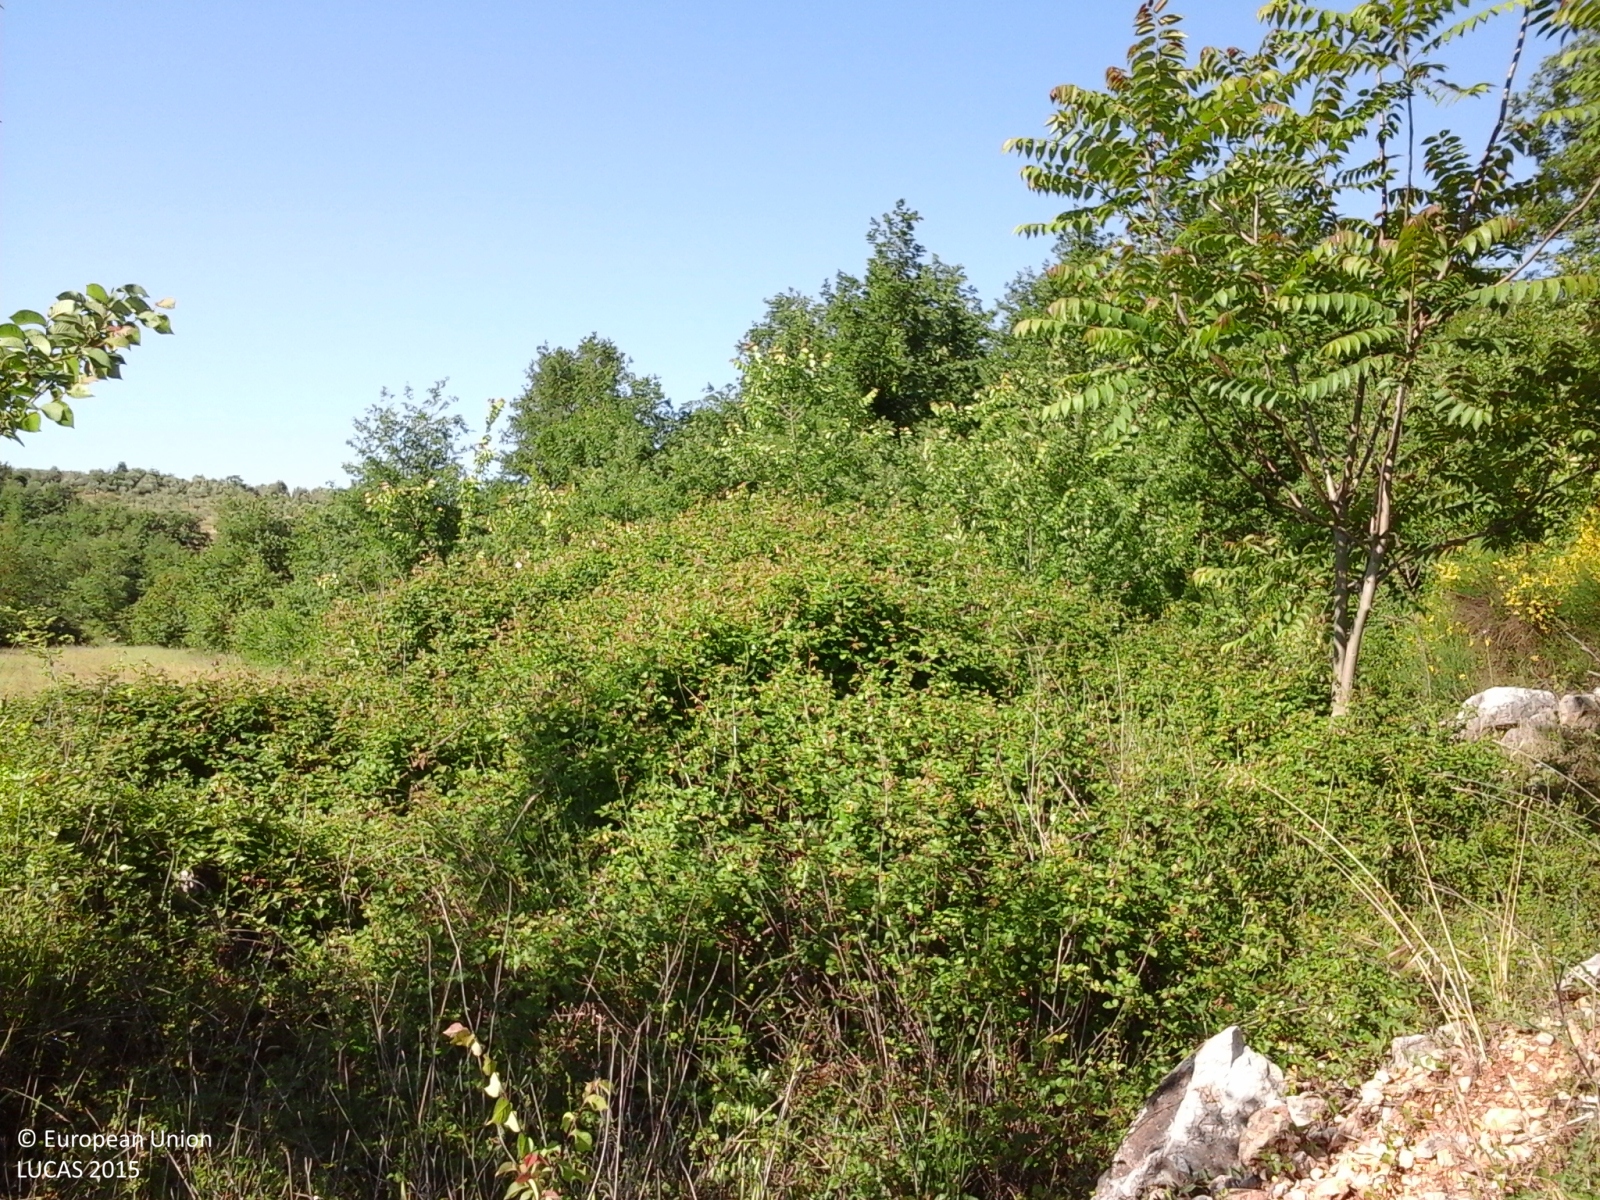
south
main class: Grassland
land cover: Grassland without tree/shrub cover
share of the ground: 50 - 75 %
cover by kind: herbaceous plants 70 %, unconsolidated bare surface 30 %
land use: Abandoned areas
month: May
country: IT
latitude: 41.6744
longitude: 13.4106
